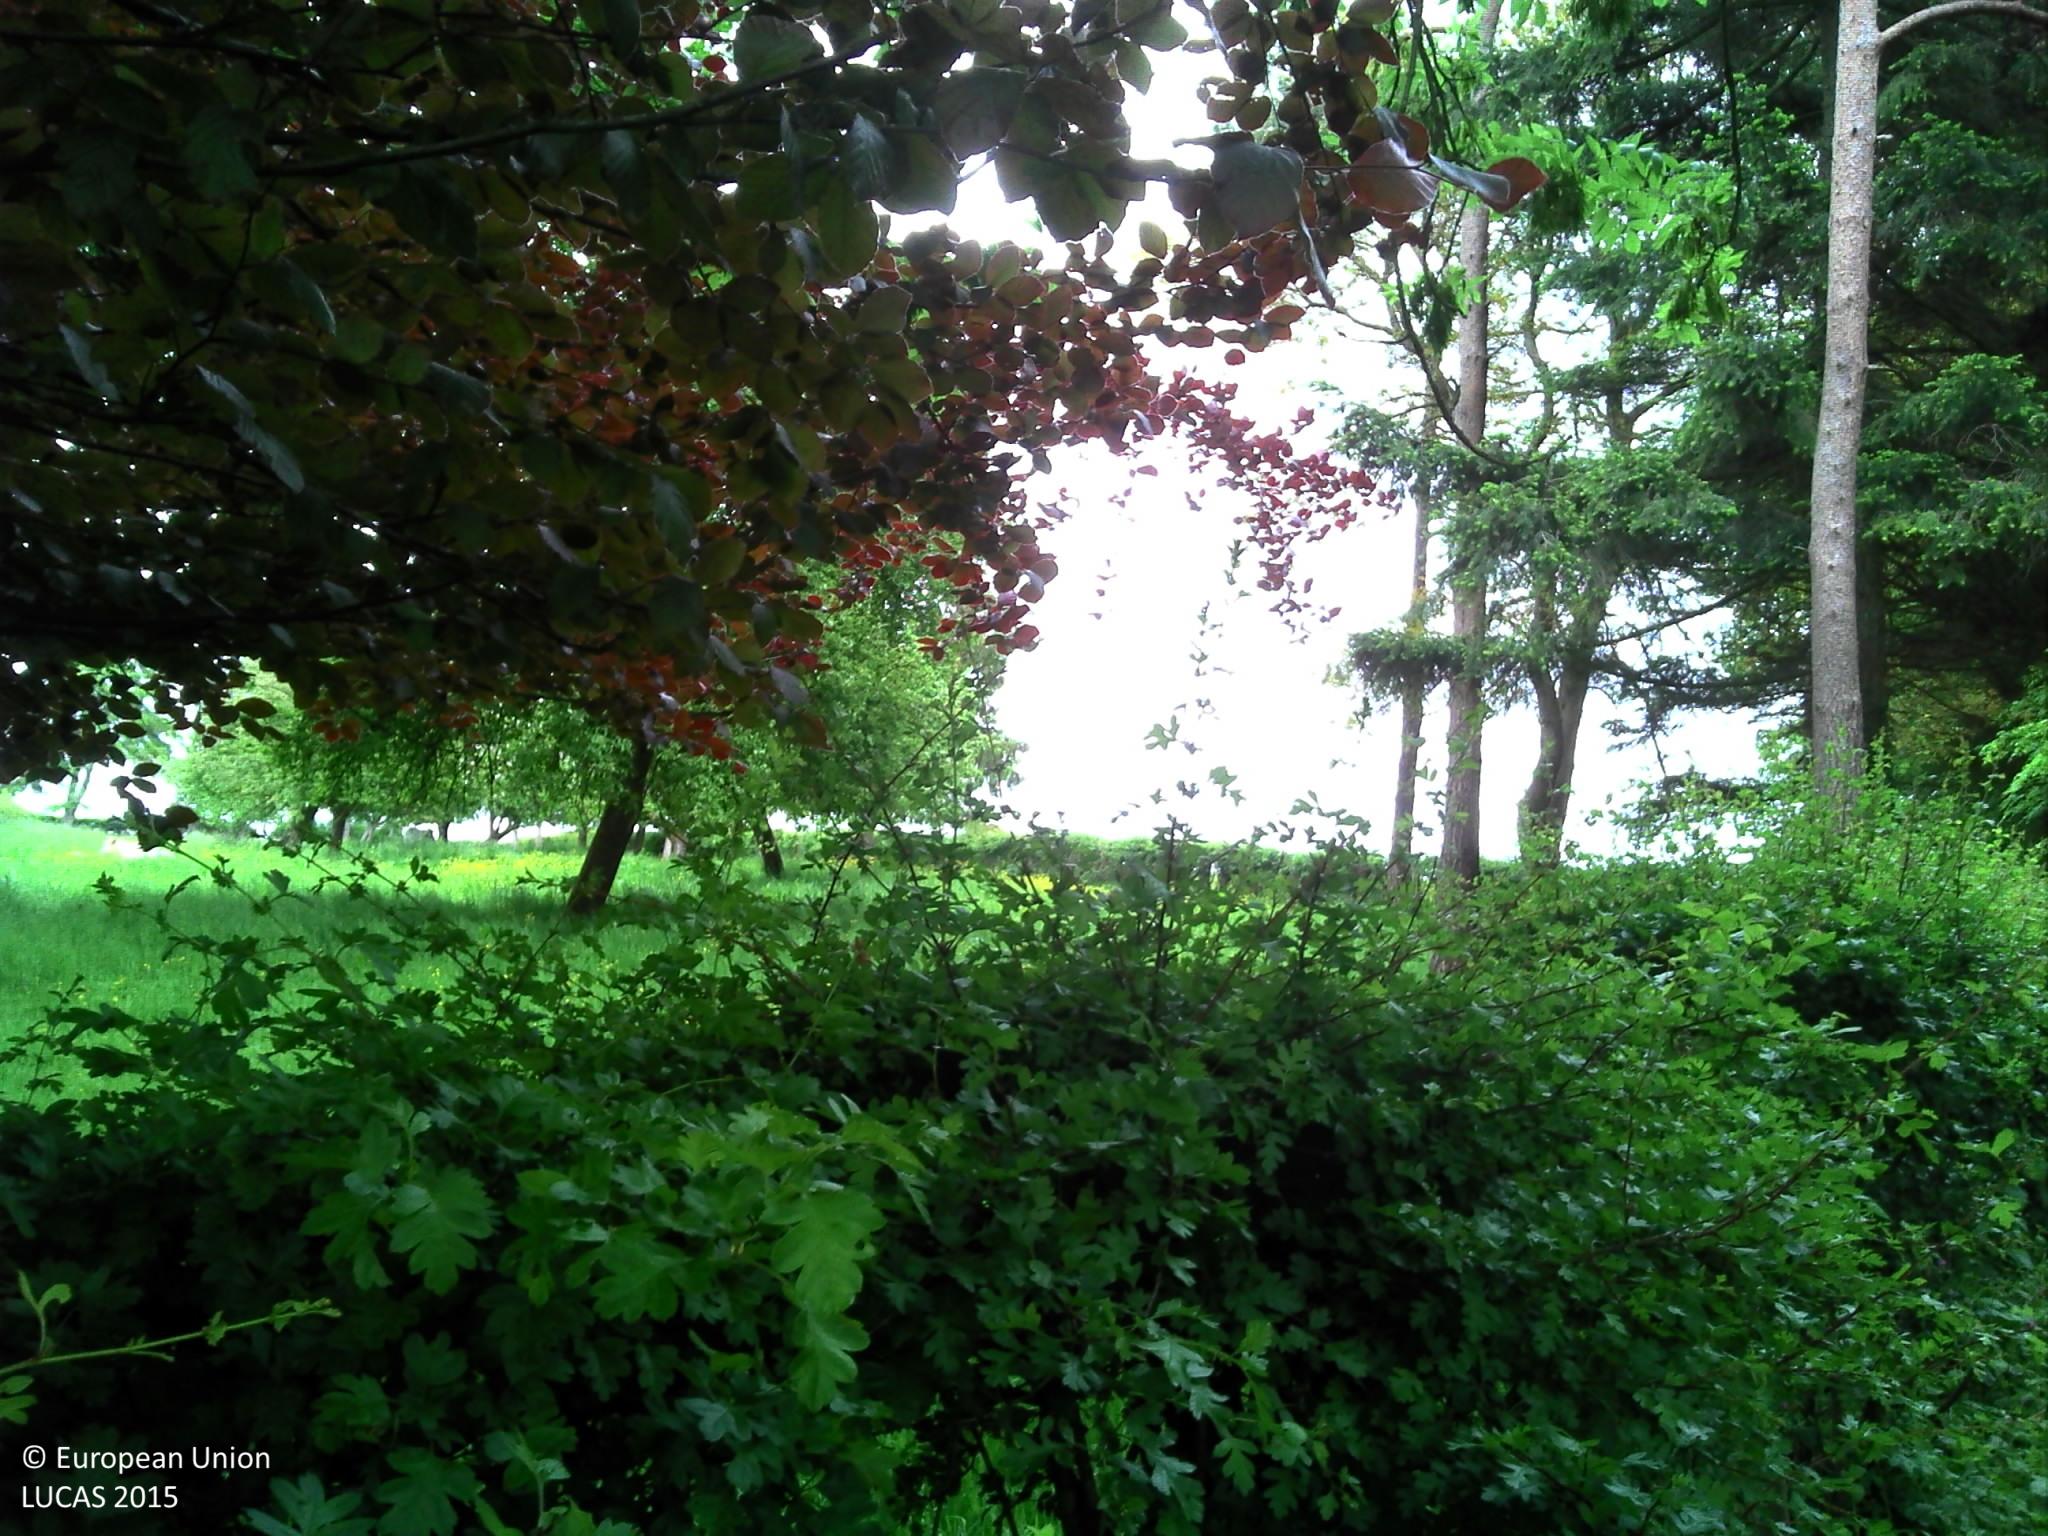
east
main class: Woodland
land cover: Broadleaved woodland
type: acidophilous oak and oak-birch forest
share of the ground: 25 - 50 %
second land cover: Grassland without tree/shrub cover
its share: > 75 %
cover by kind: herbaceous plants 80 %, broadleaved forest trees 15 %, coniferous forest trees 5 %
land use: Forestry
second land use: Agriculture (excluding fallow land and kitchen gardens)
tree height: > 5 m
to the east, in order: Managed hedges; Broadleaved woodland; Managed hedges; Grassland without tree/shrub cover; Fences; Tracks; Common wheat; Rape and turnip rape
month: May
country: FR
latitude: 50.4865
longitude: 2.0779
